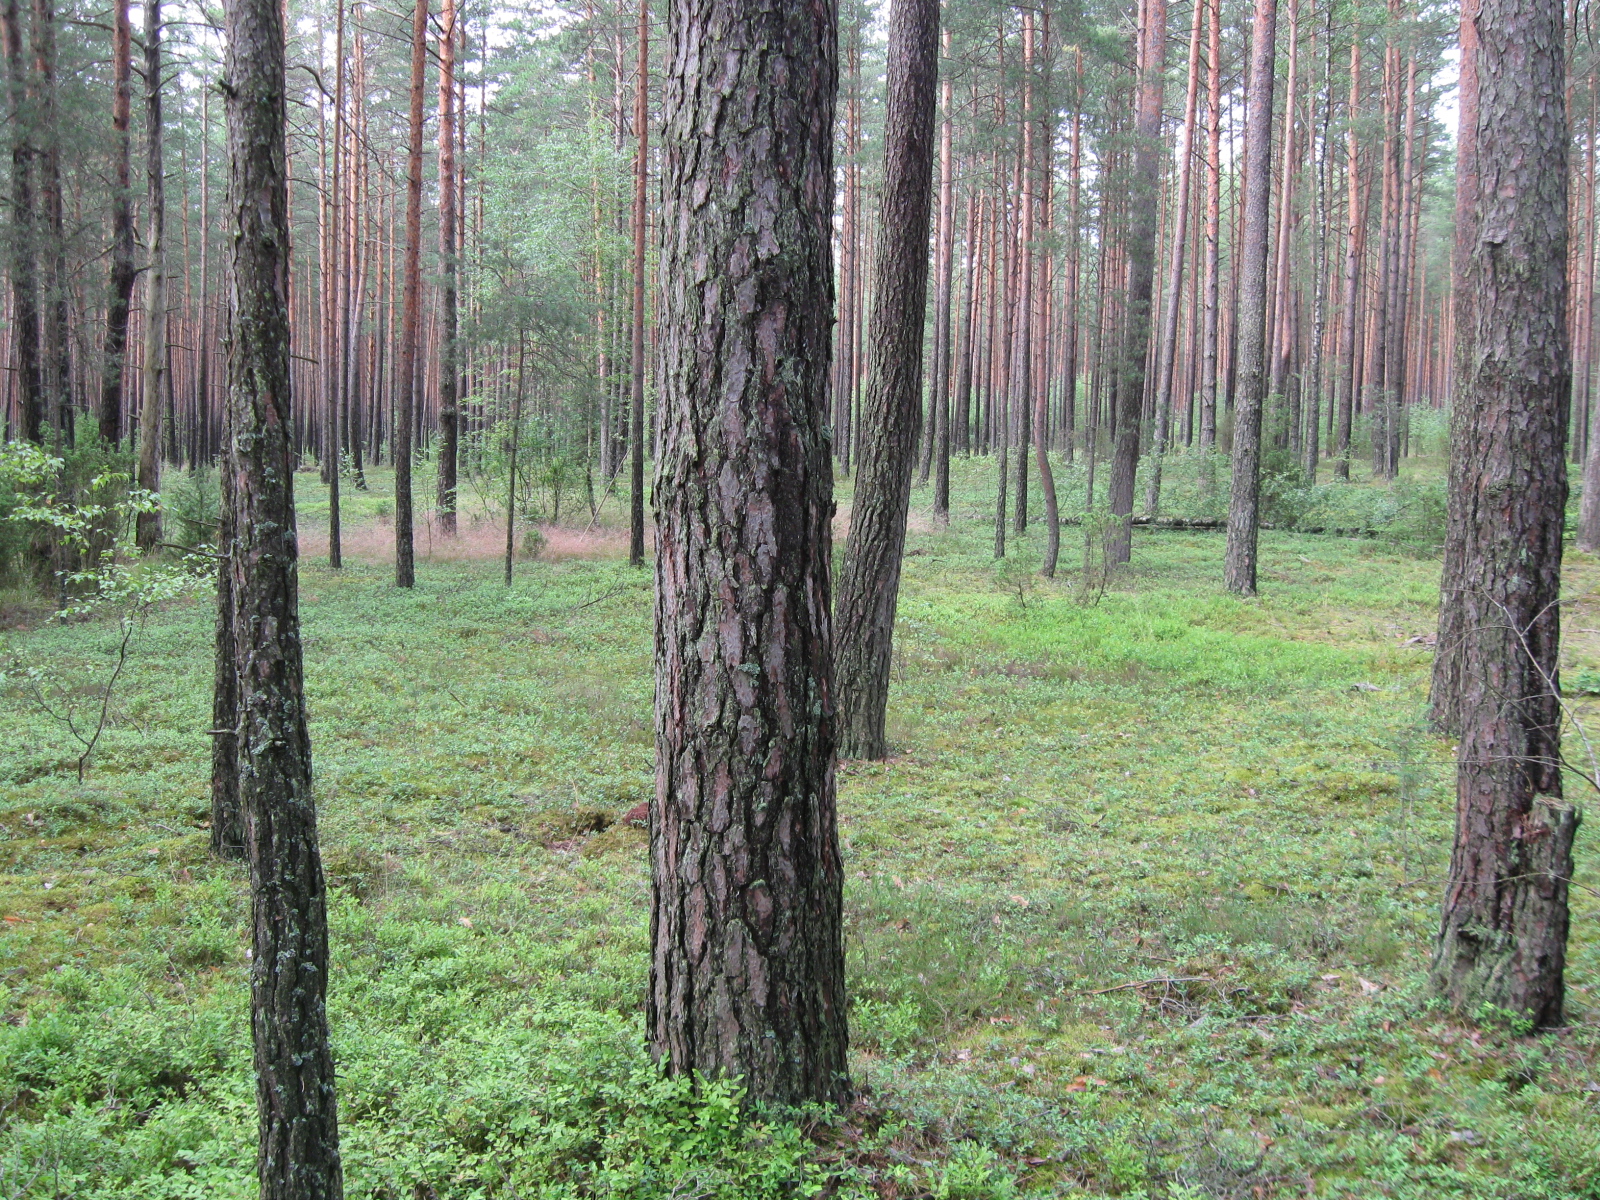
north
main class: Woodland
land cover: Pine dominated coniferous woodland
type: hemiboreal forest and nemoral coniferous forest and mixed broadleaved-coniferous forest
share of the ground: 50 - 75 %
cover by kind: coniferous forest trees 65 %, shrubs 15 %, lichens and mosses 10 %, broadleaved forest trees 5 %, herbaceous plants 5 %
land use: Forestry
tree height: > 5 m
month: July
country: LT
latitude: 53.9716
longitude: 23.5143
